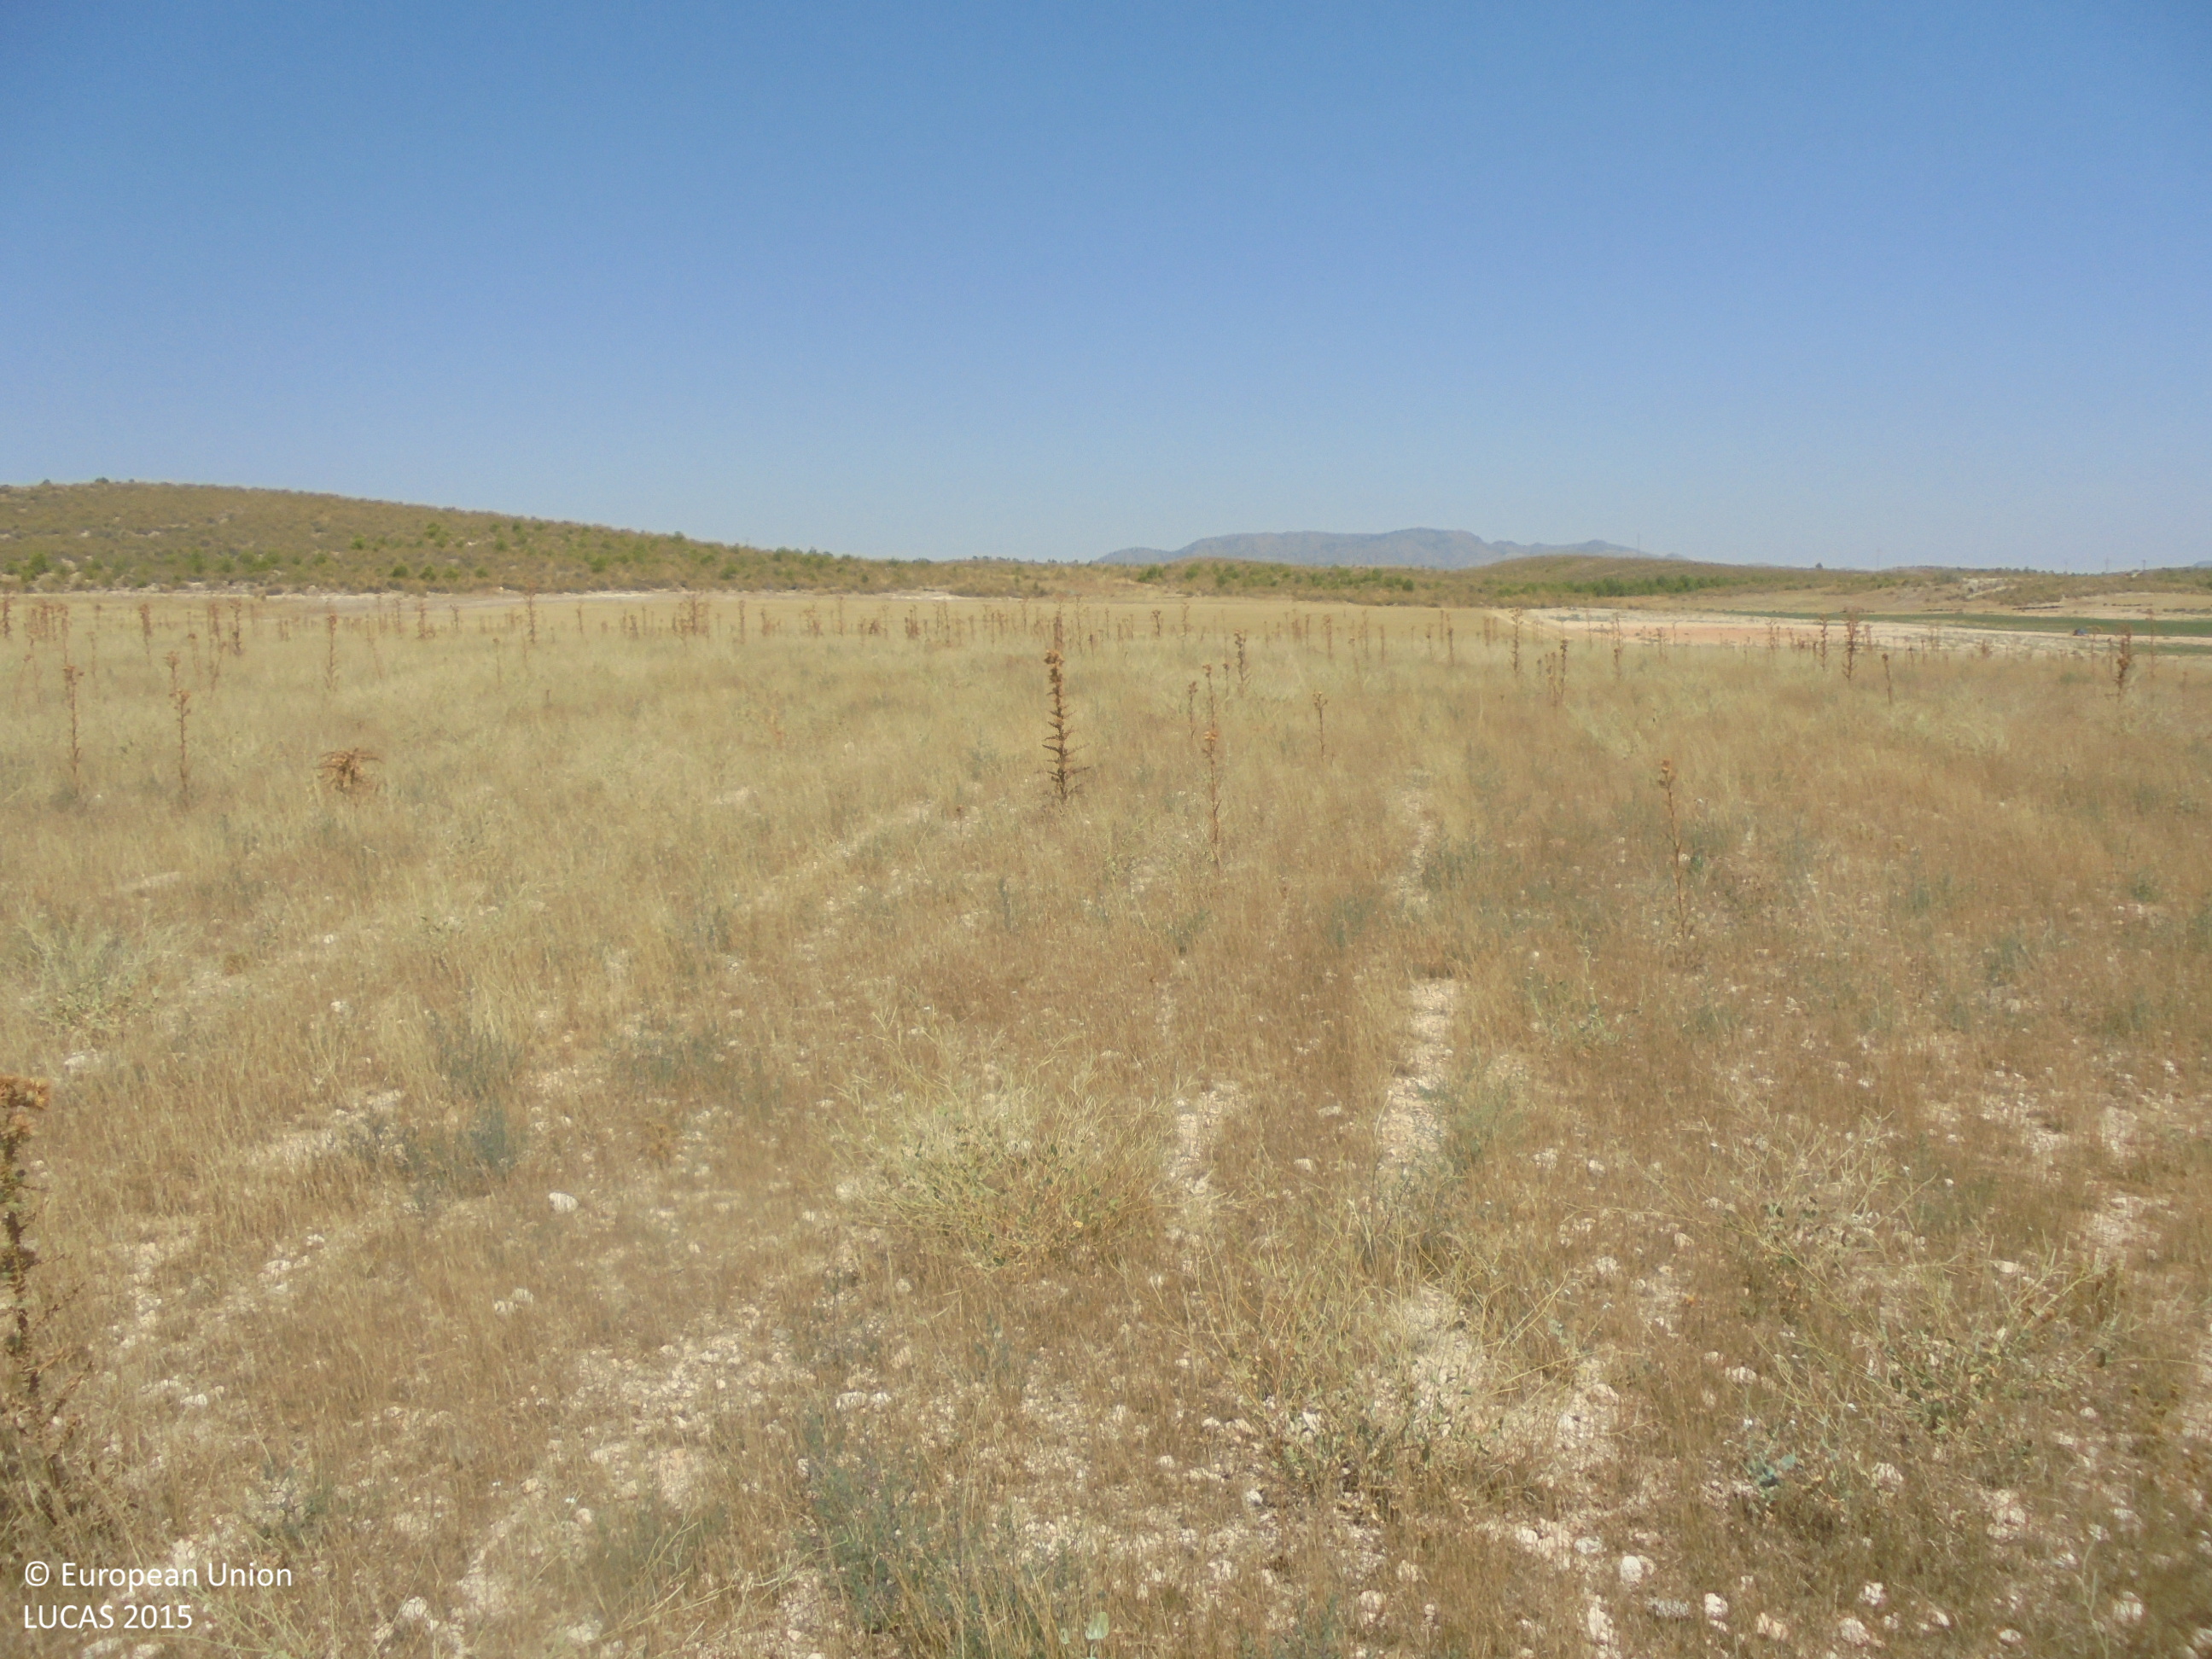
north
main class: Grassland
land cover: Spontaneously vegetated surfaces
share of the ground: > 75 %
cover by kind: herbaceous plants 80 %, unconsolidated bare surface 20 %
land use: Fallow land
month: July
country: ES
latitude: 38.5597
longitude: -1.5492
